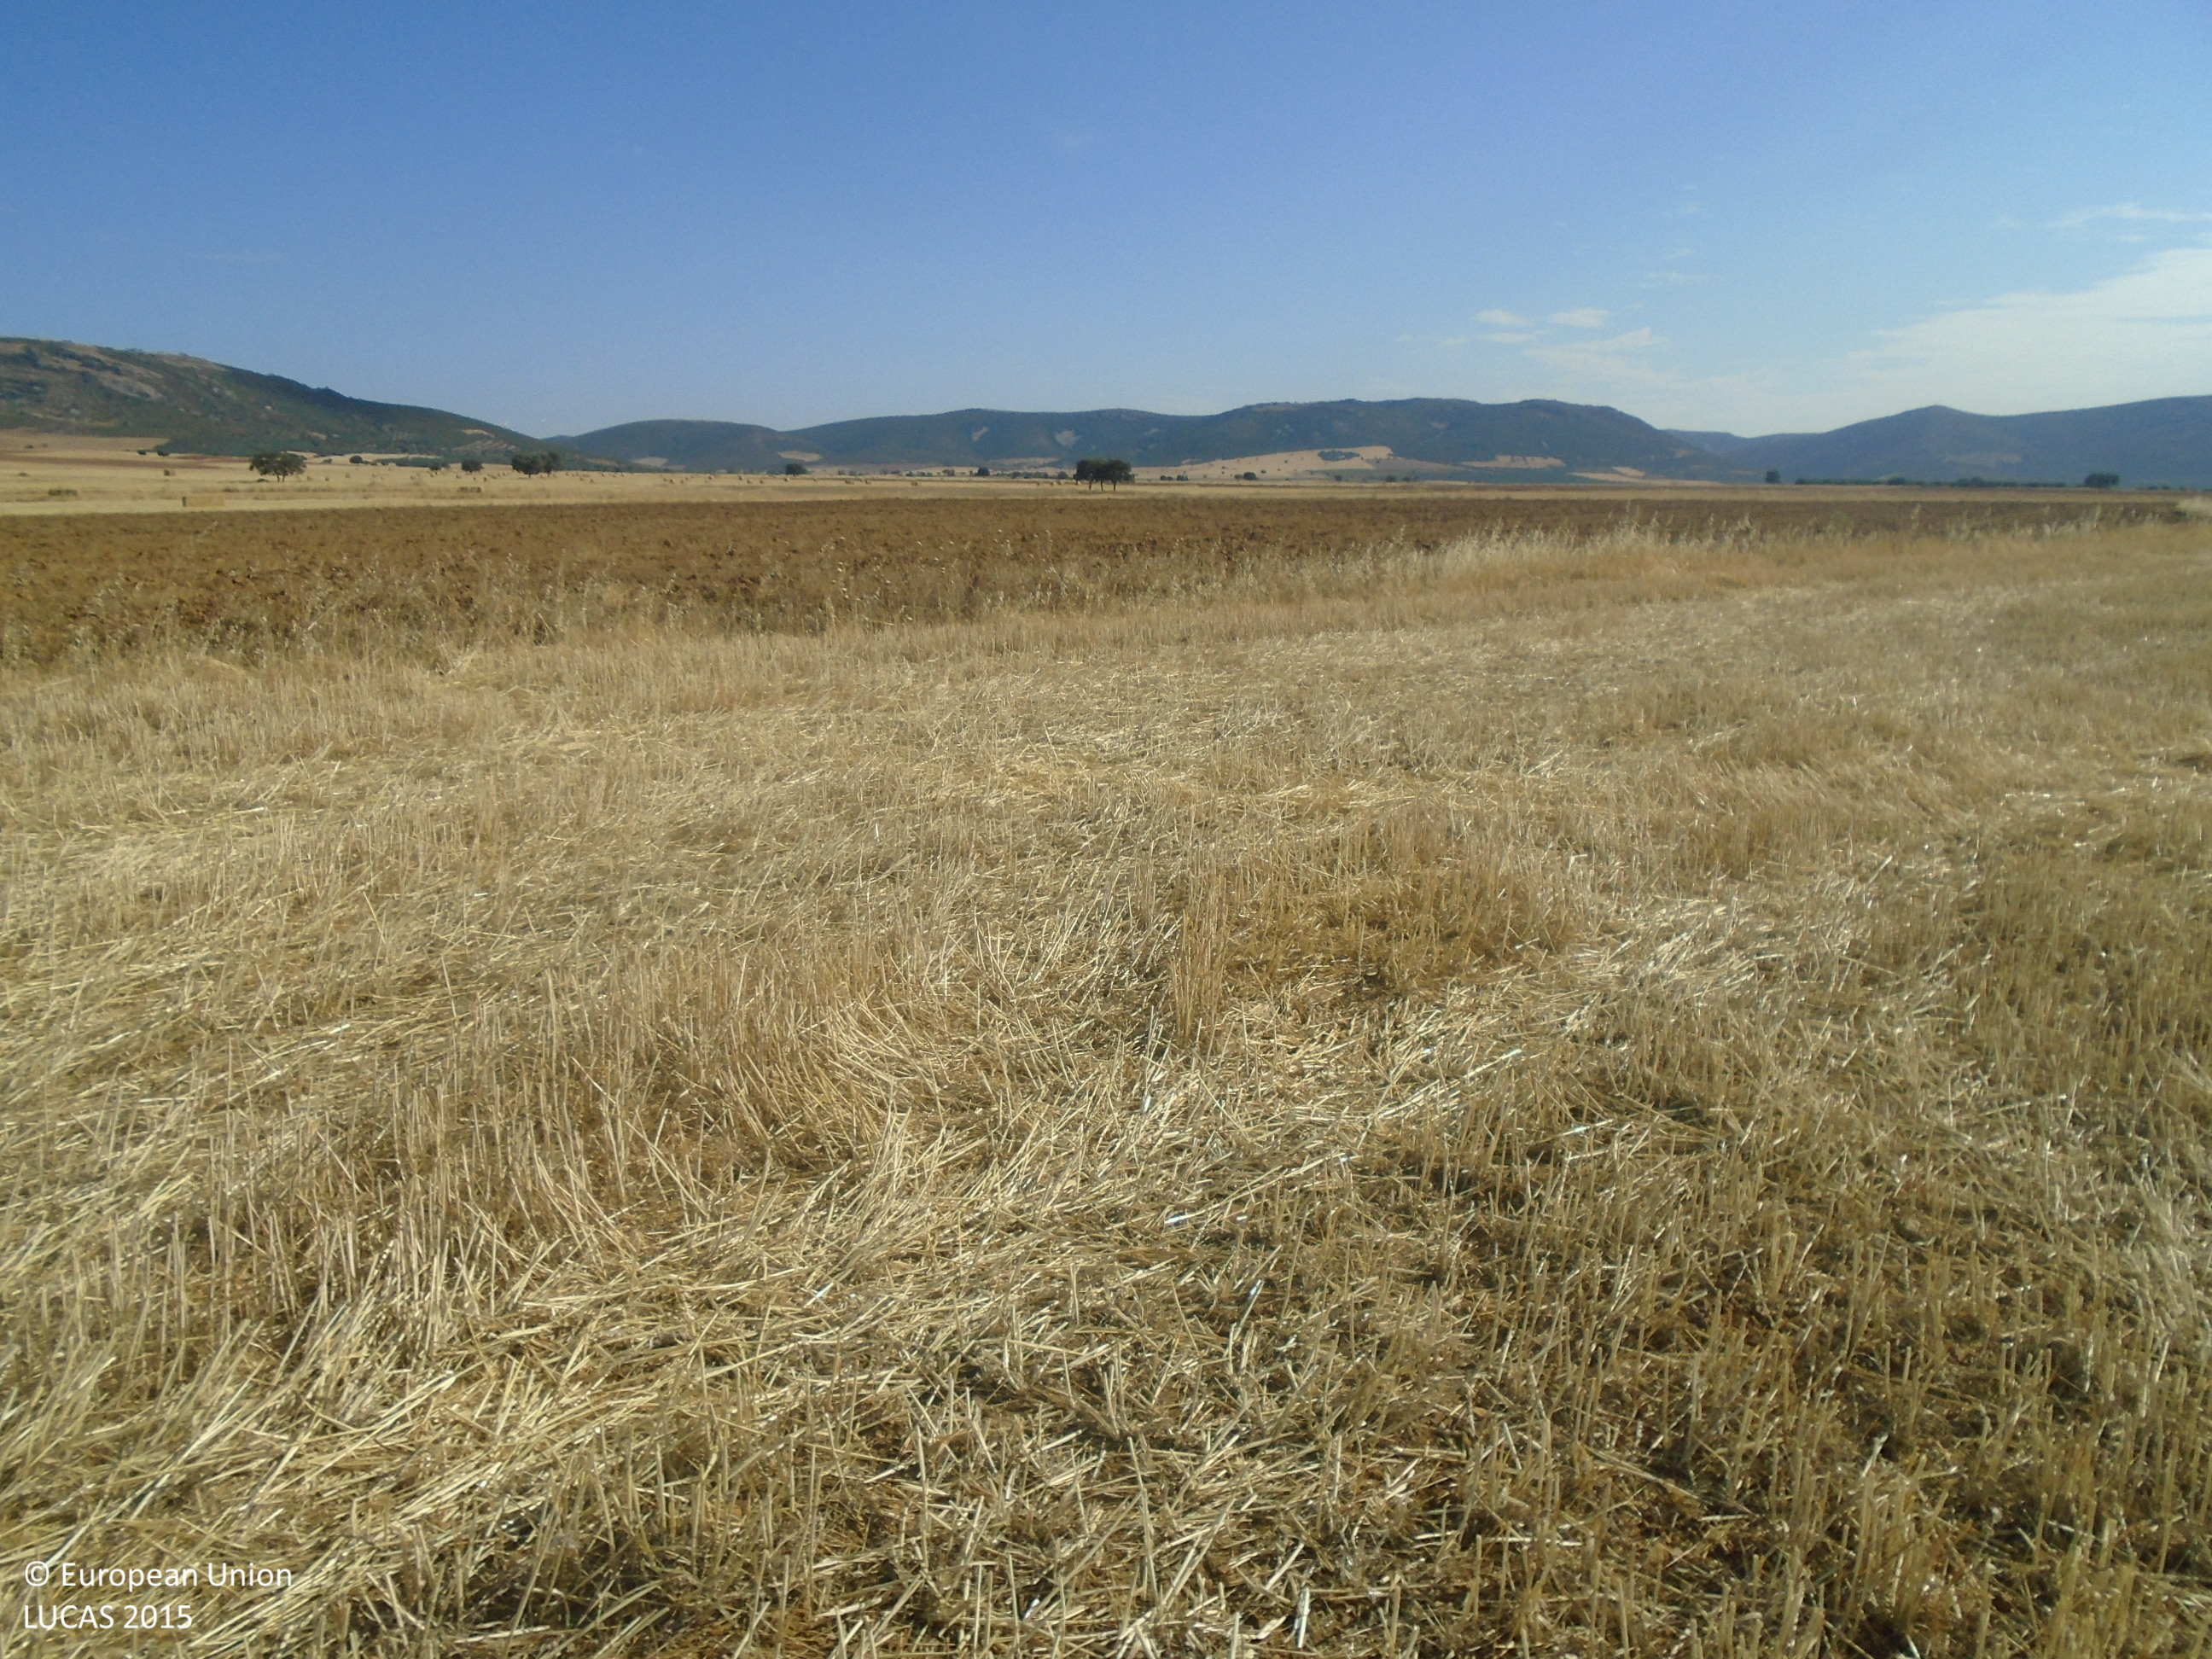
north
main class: Cropland
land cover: Common wheat
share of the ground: < 10 %
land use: Agriculture (excluding fallow land and kitchen gardens)
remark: Harvested field
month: July
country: ES
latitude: 39.1717
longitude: -4.0886
